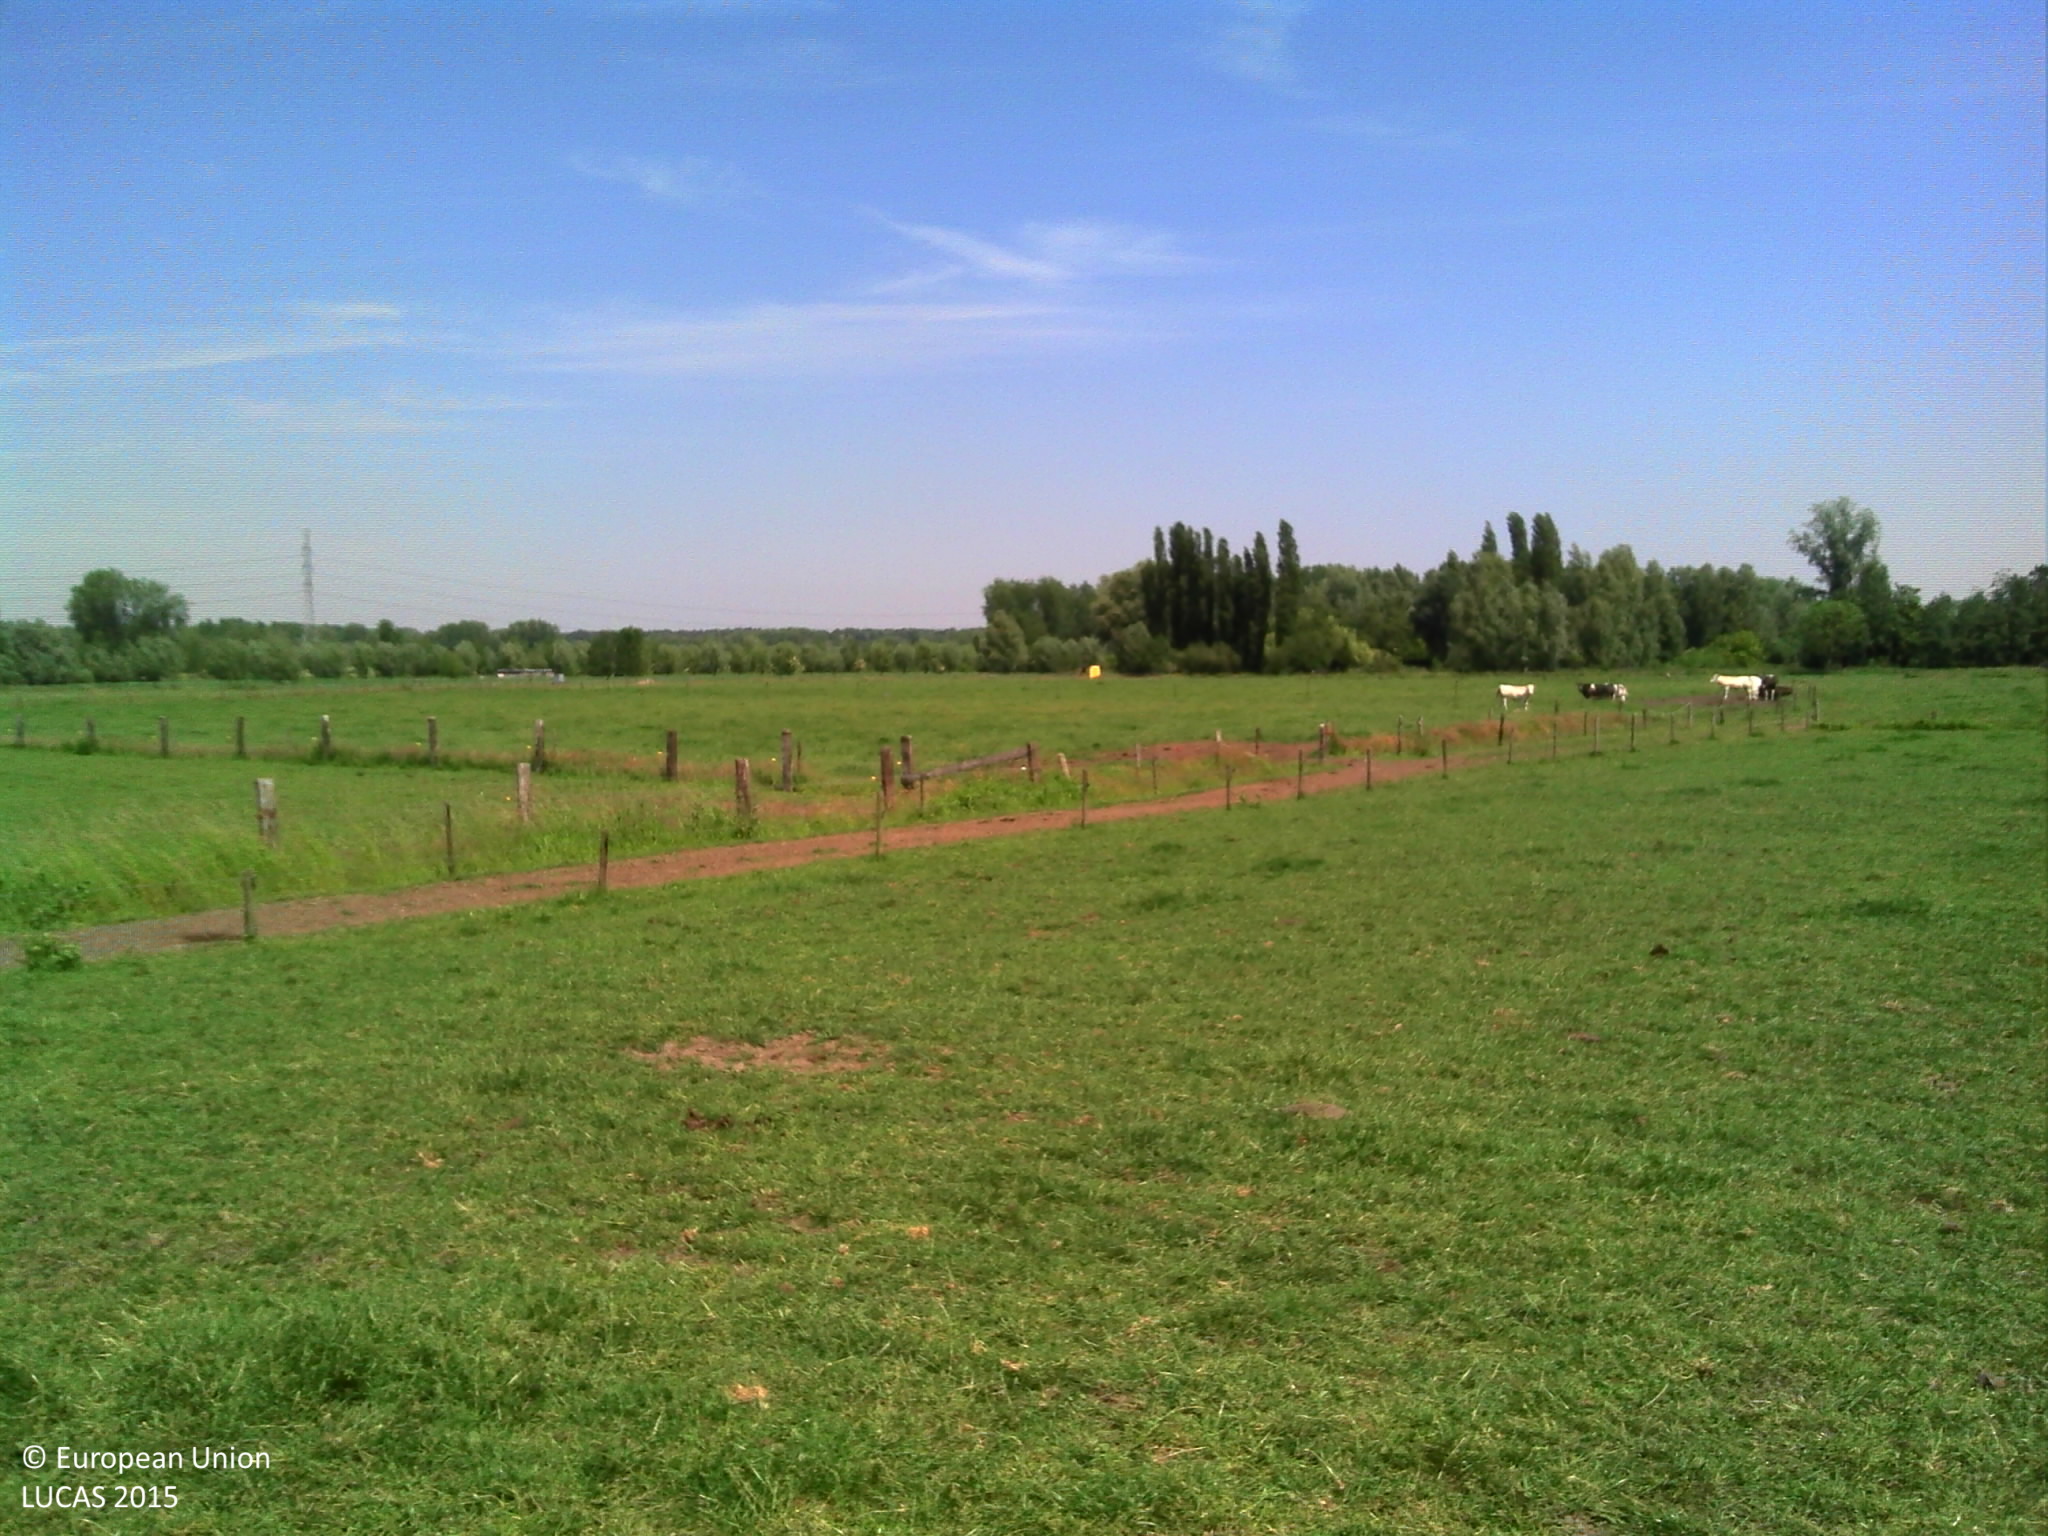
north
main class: Grassland
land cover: Grassland without tree/shrub cover
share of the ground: > 75 %
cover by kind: herbaceous plants 100 %
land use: Agriculture (excluding fallow land and kitchen gardens)
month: June
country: BE
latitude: 51.0950
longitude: 4.0972
